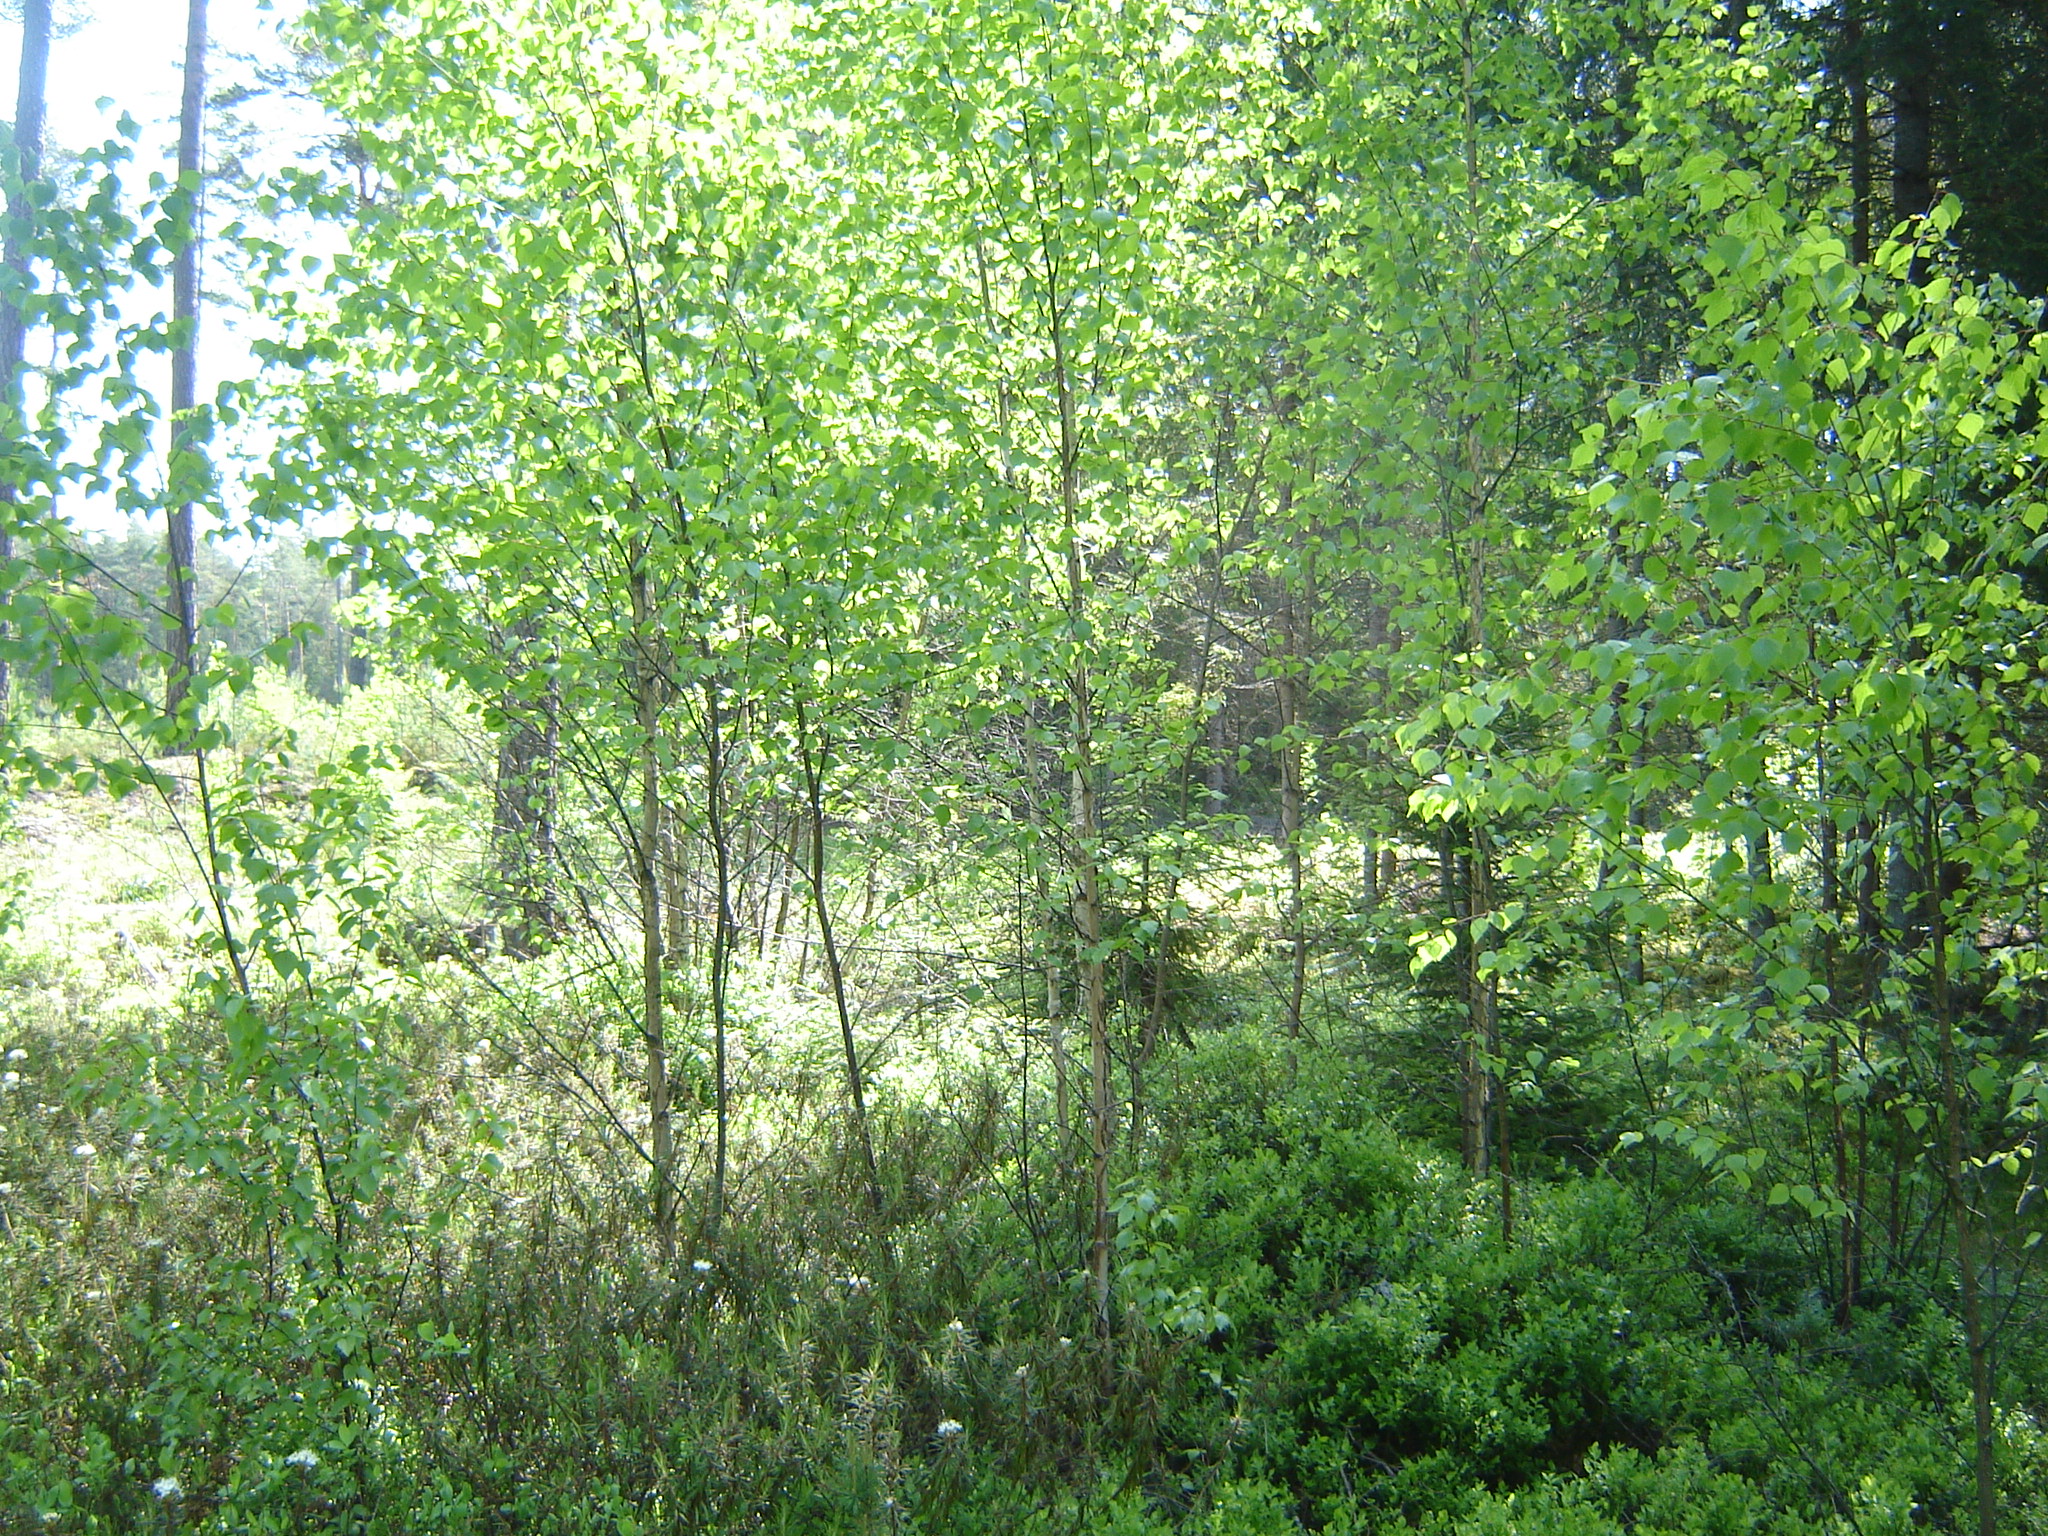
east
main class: Woodland
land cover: Pine dominated mixed woodland
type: hemiboreal forest and nemoral coniferous forest and mixed broadleaved-coniferous forest
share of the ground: 50 - 75 %
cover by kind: coniferous forest trees 40 %, broadleaved forest trees 30 %, lichens and mosses 30 %
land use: Forestry
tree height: > 5 m
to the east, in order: Pine dominated mixed woodland; Tracks; Pine dominated mixed woodland; Fences; Pine dominated coniferous woodland
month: May
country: LT
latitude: 55.7044
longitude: 25.2835
